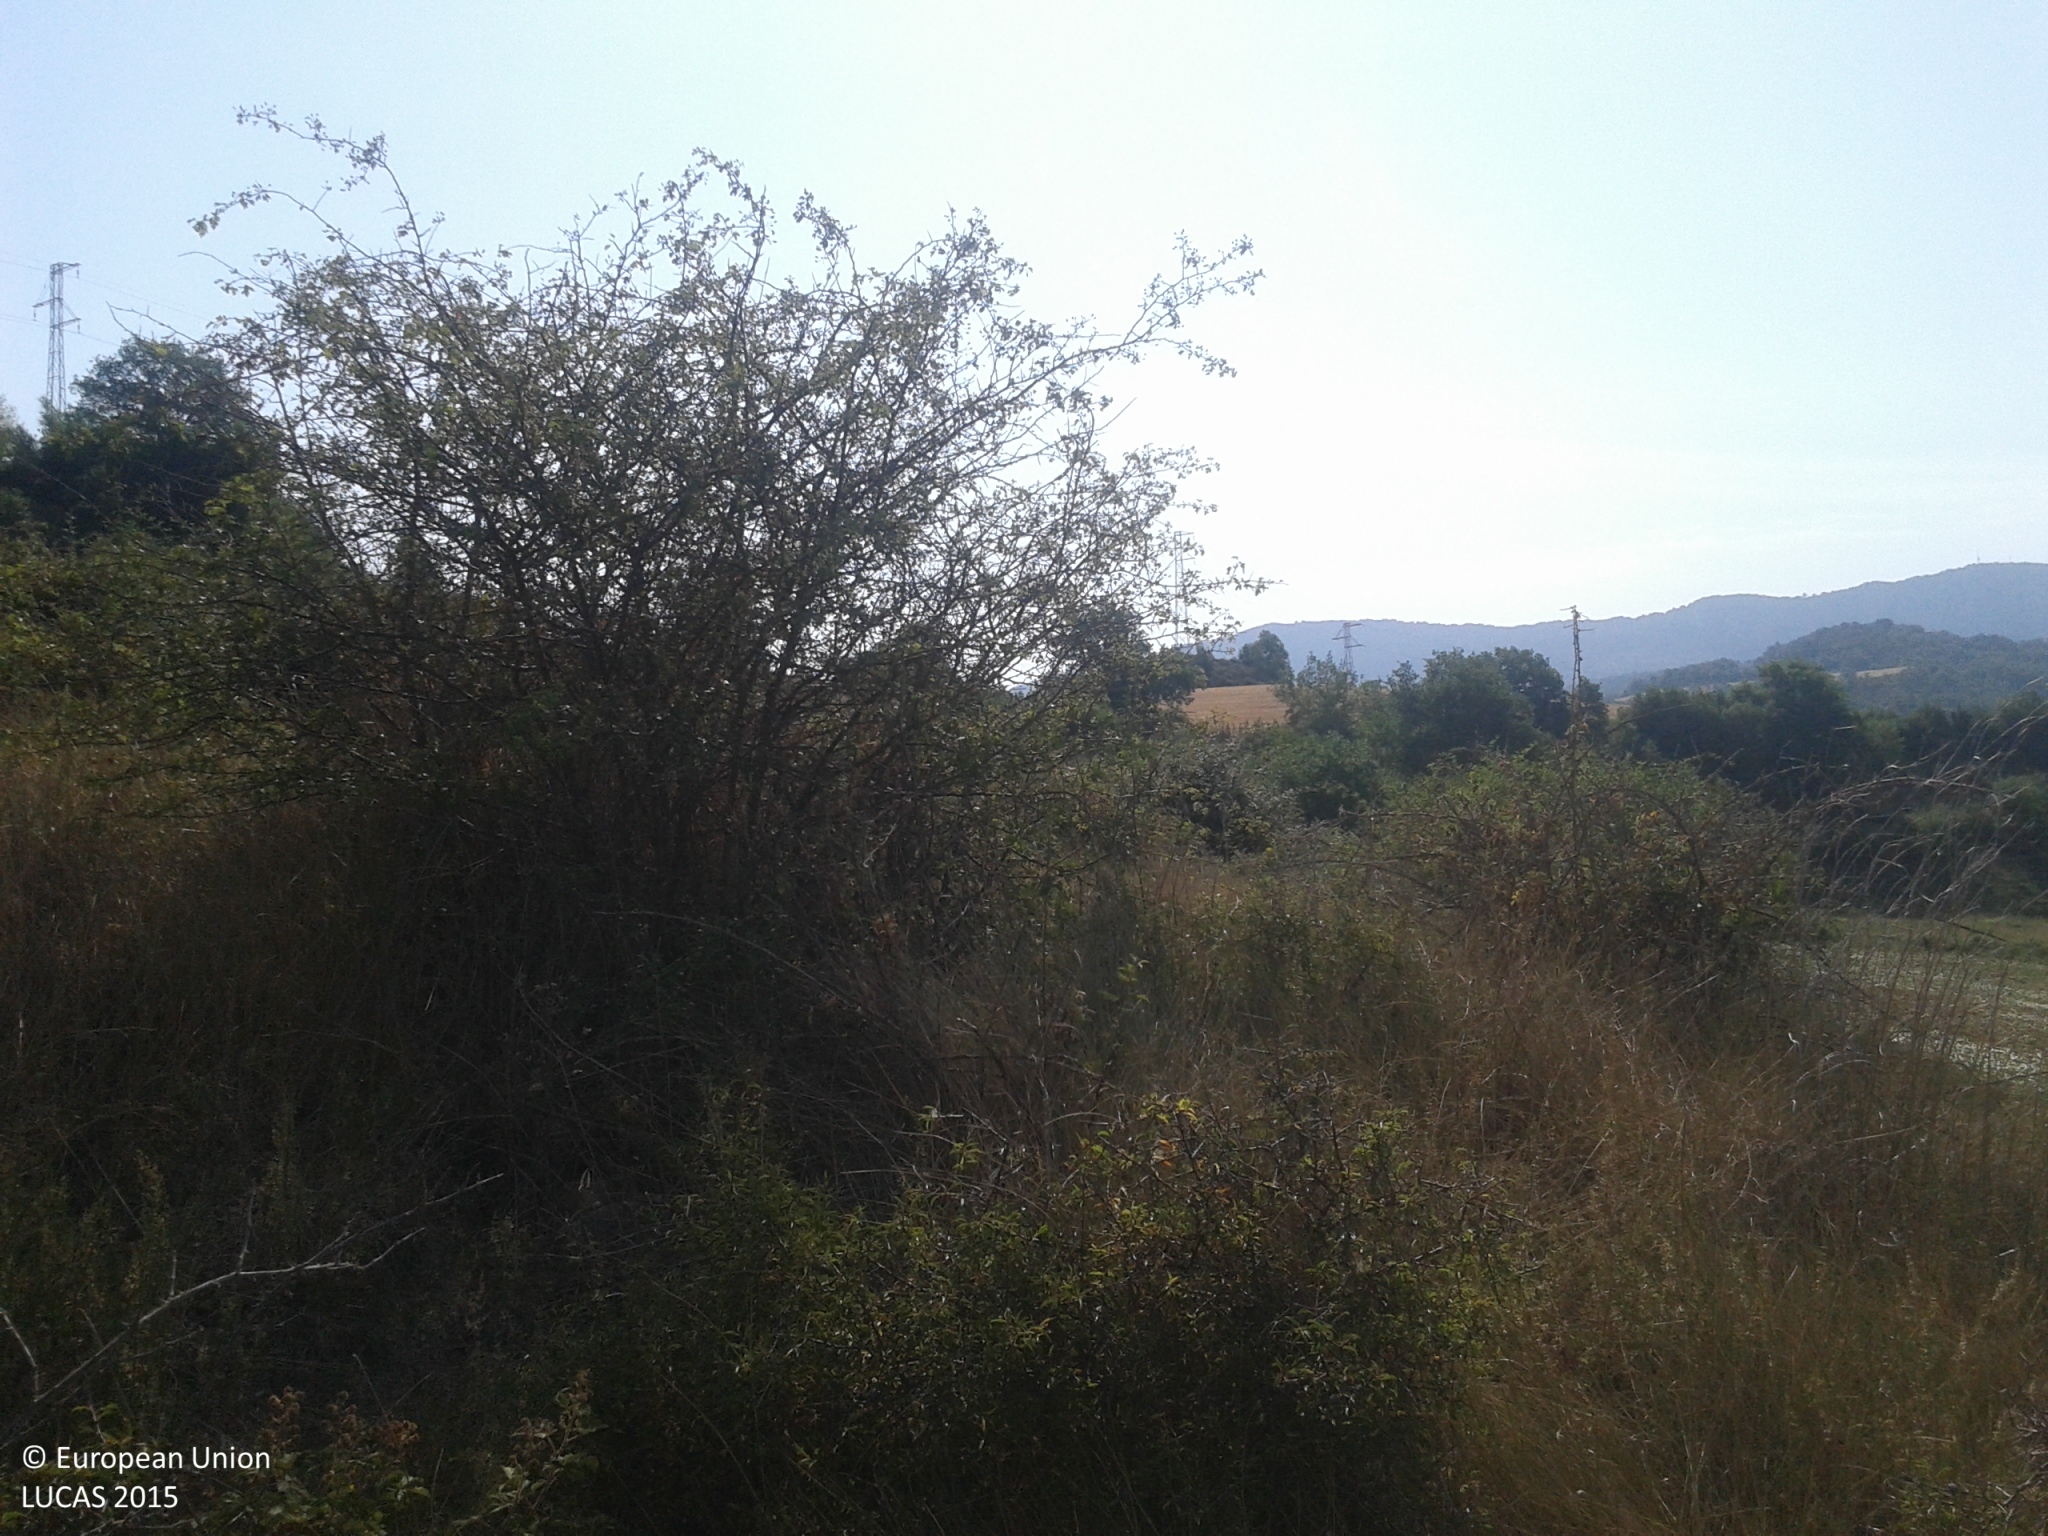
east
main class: Shrubland
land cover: Shrubland without tree cover
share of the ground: 50 - 75 %
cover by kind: shrubs 55 %, herbaceous plants 45 %
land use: Semi-natural and natural areas not in use
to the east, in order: Shrubland without tree cover; Lucerne; Grassland with sparse tree/shrub cover; Grassland without tree/shrub cover; Broadleaved woodland; Common wheat; Electric lines; Common wheat
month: July
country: ES
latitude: 42.0938
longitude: 1.0510
